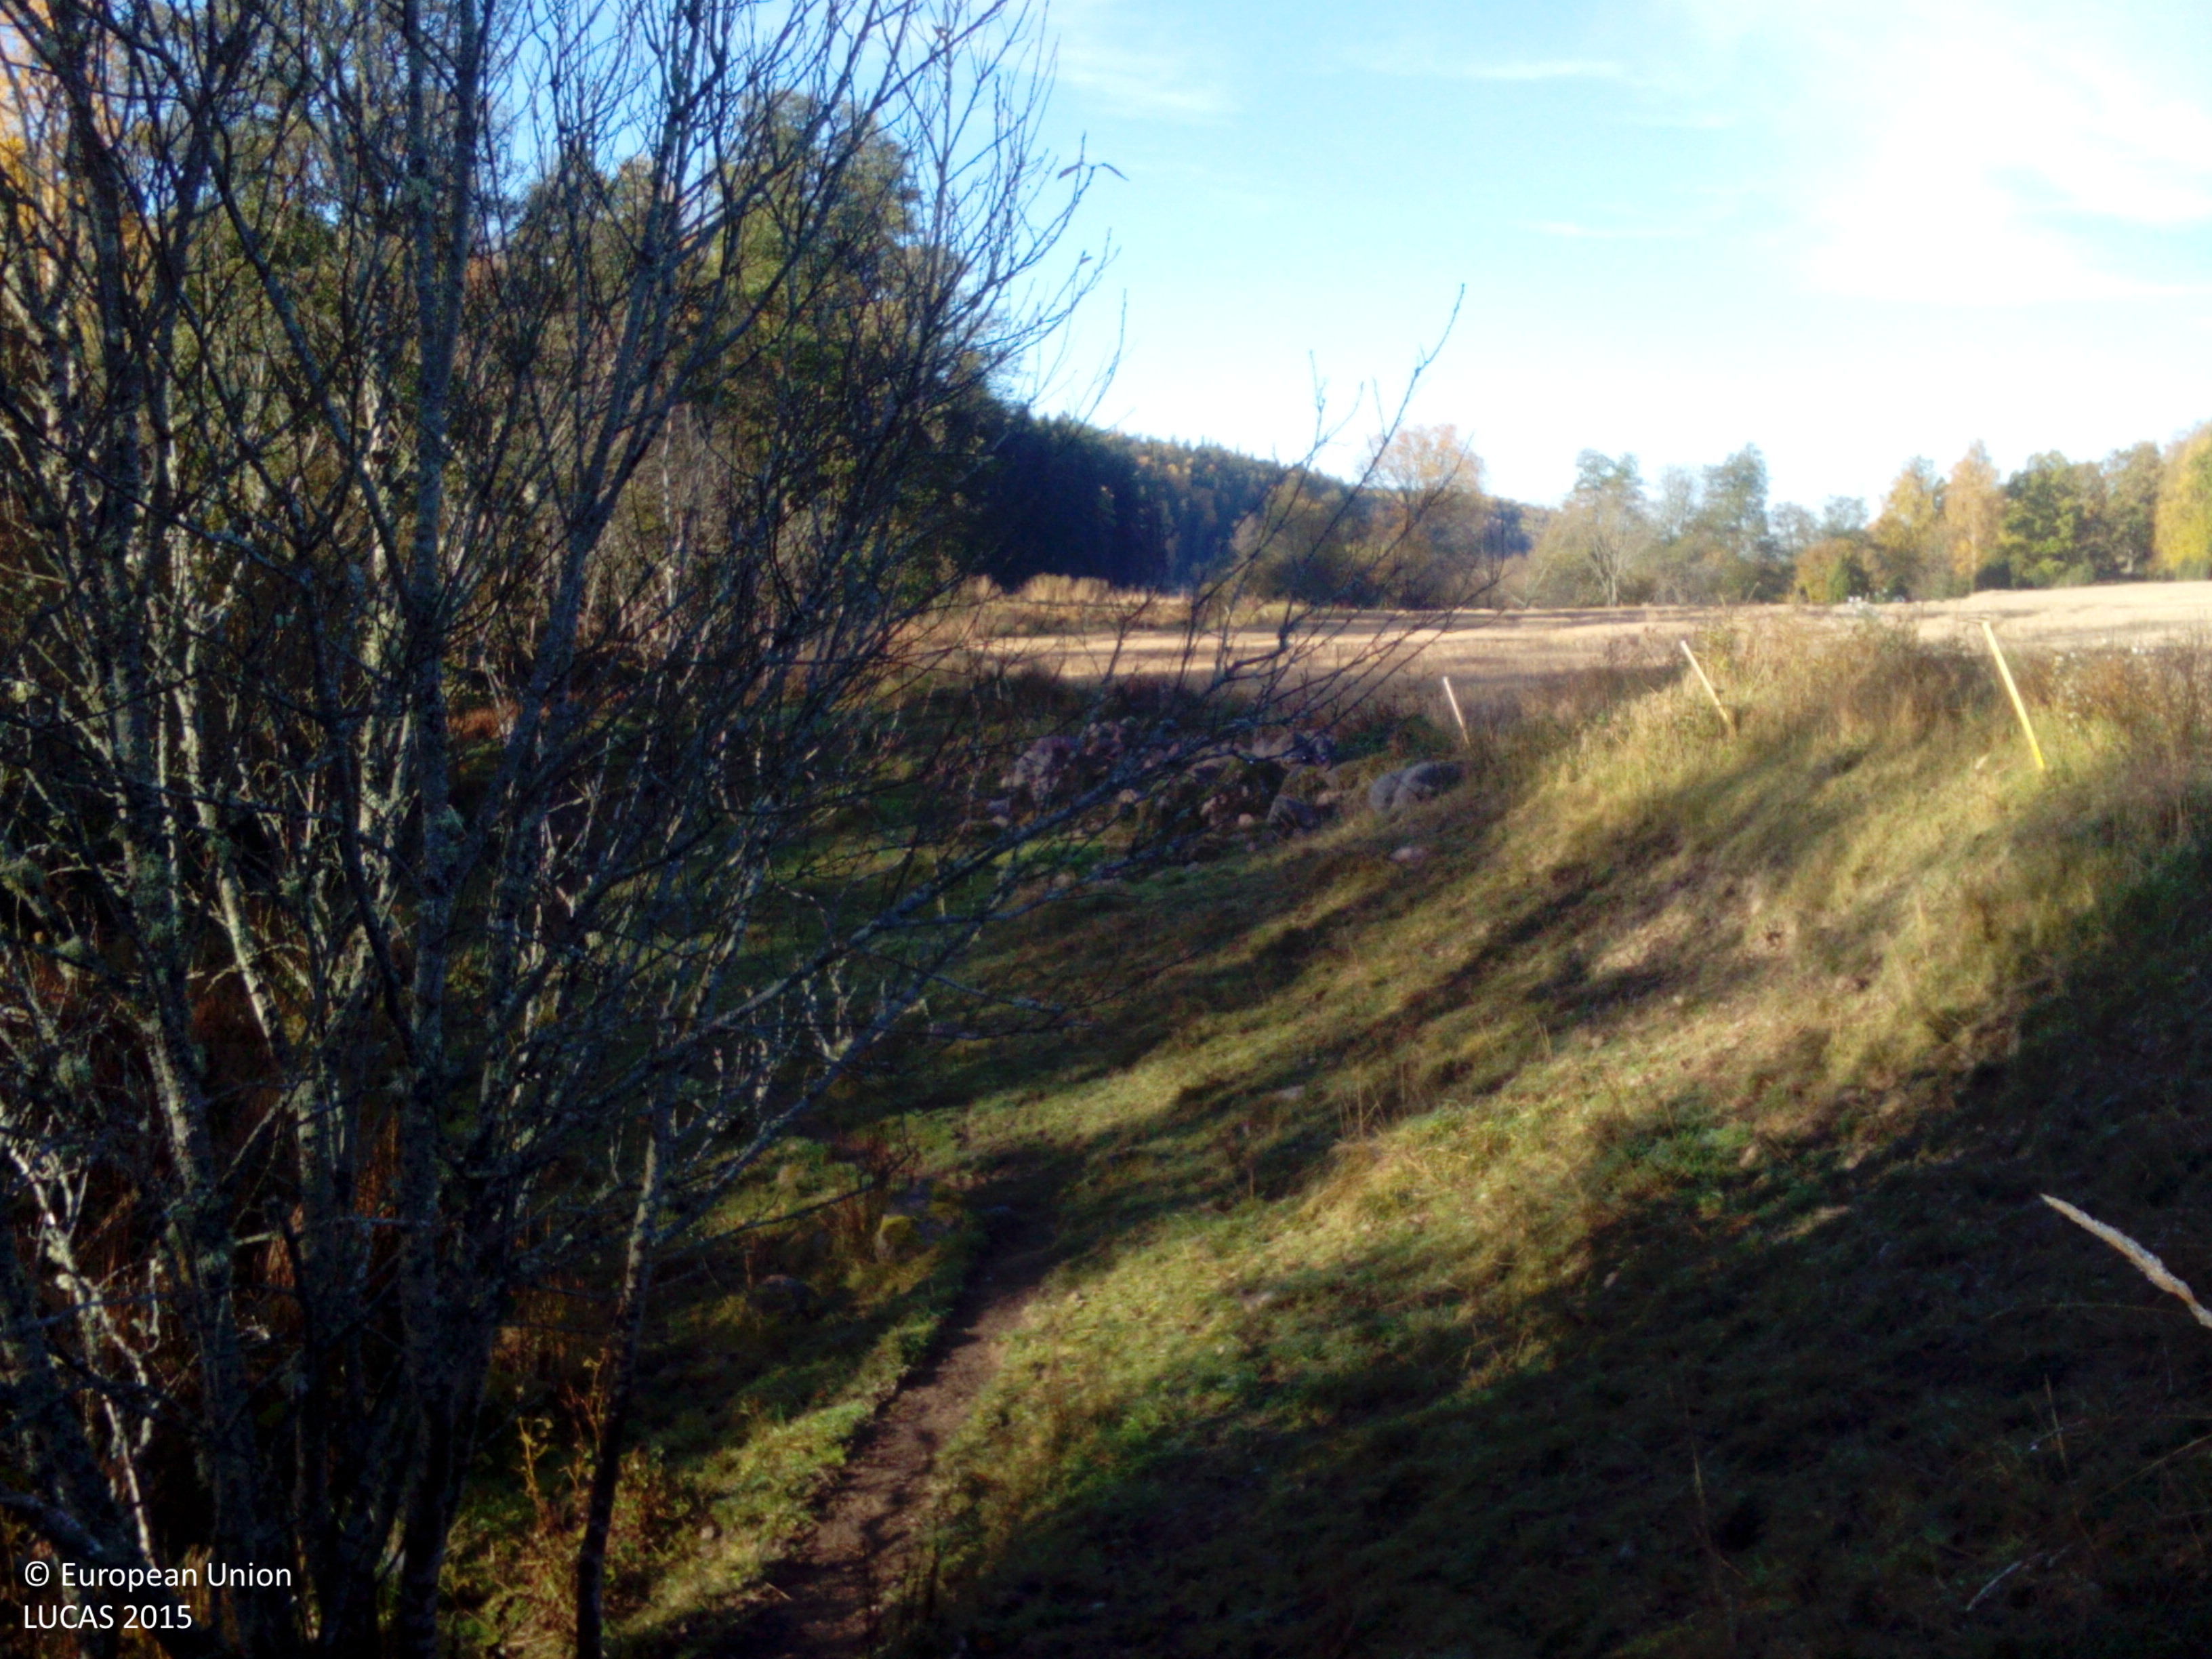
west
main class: Grassland
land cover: Grassland without tree/shrub cover
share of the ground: > 75 %
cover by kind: herbaceous plants 100 %
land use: Agriculture (excluding fallow land and kitchen gardens)
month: October
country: SE
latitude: 59.0831
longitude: 16.2929
